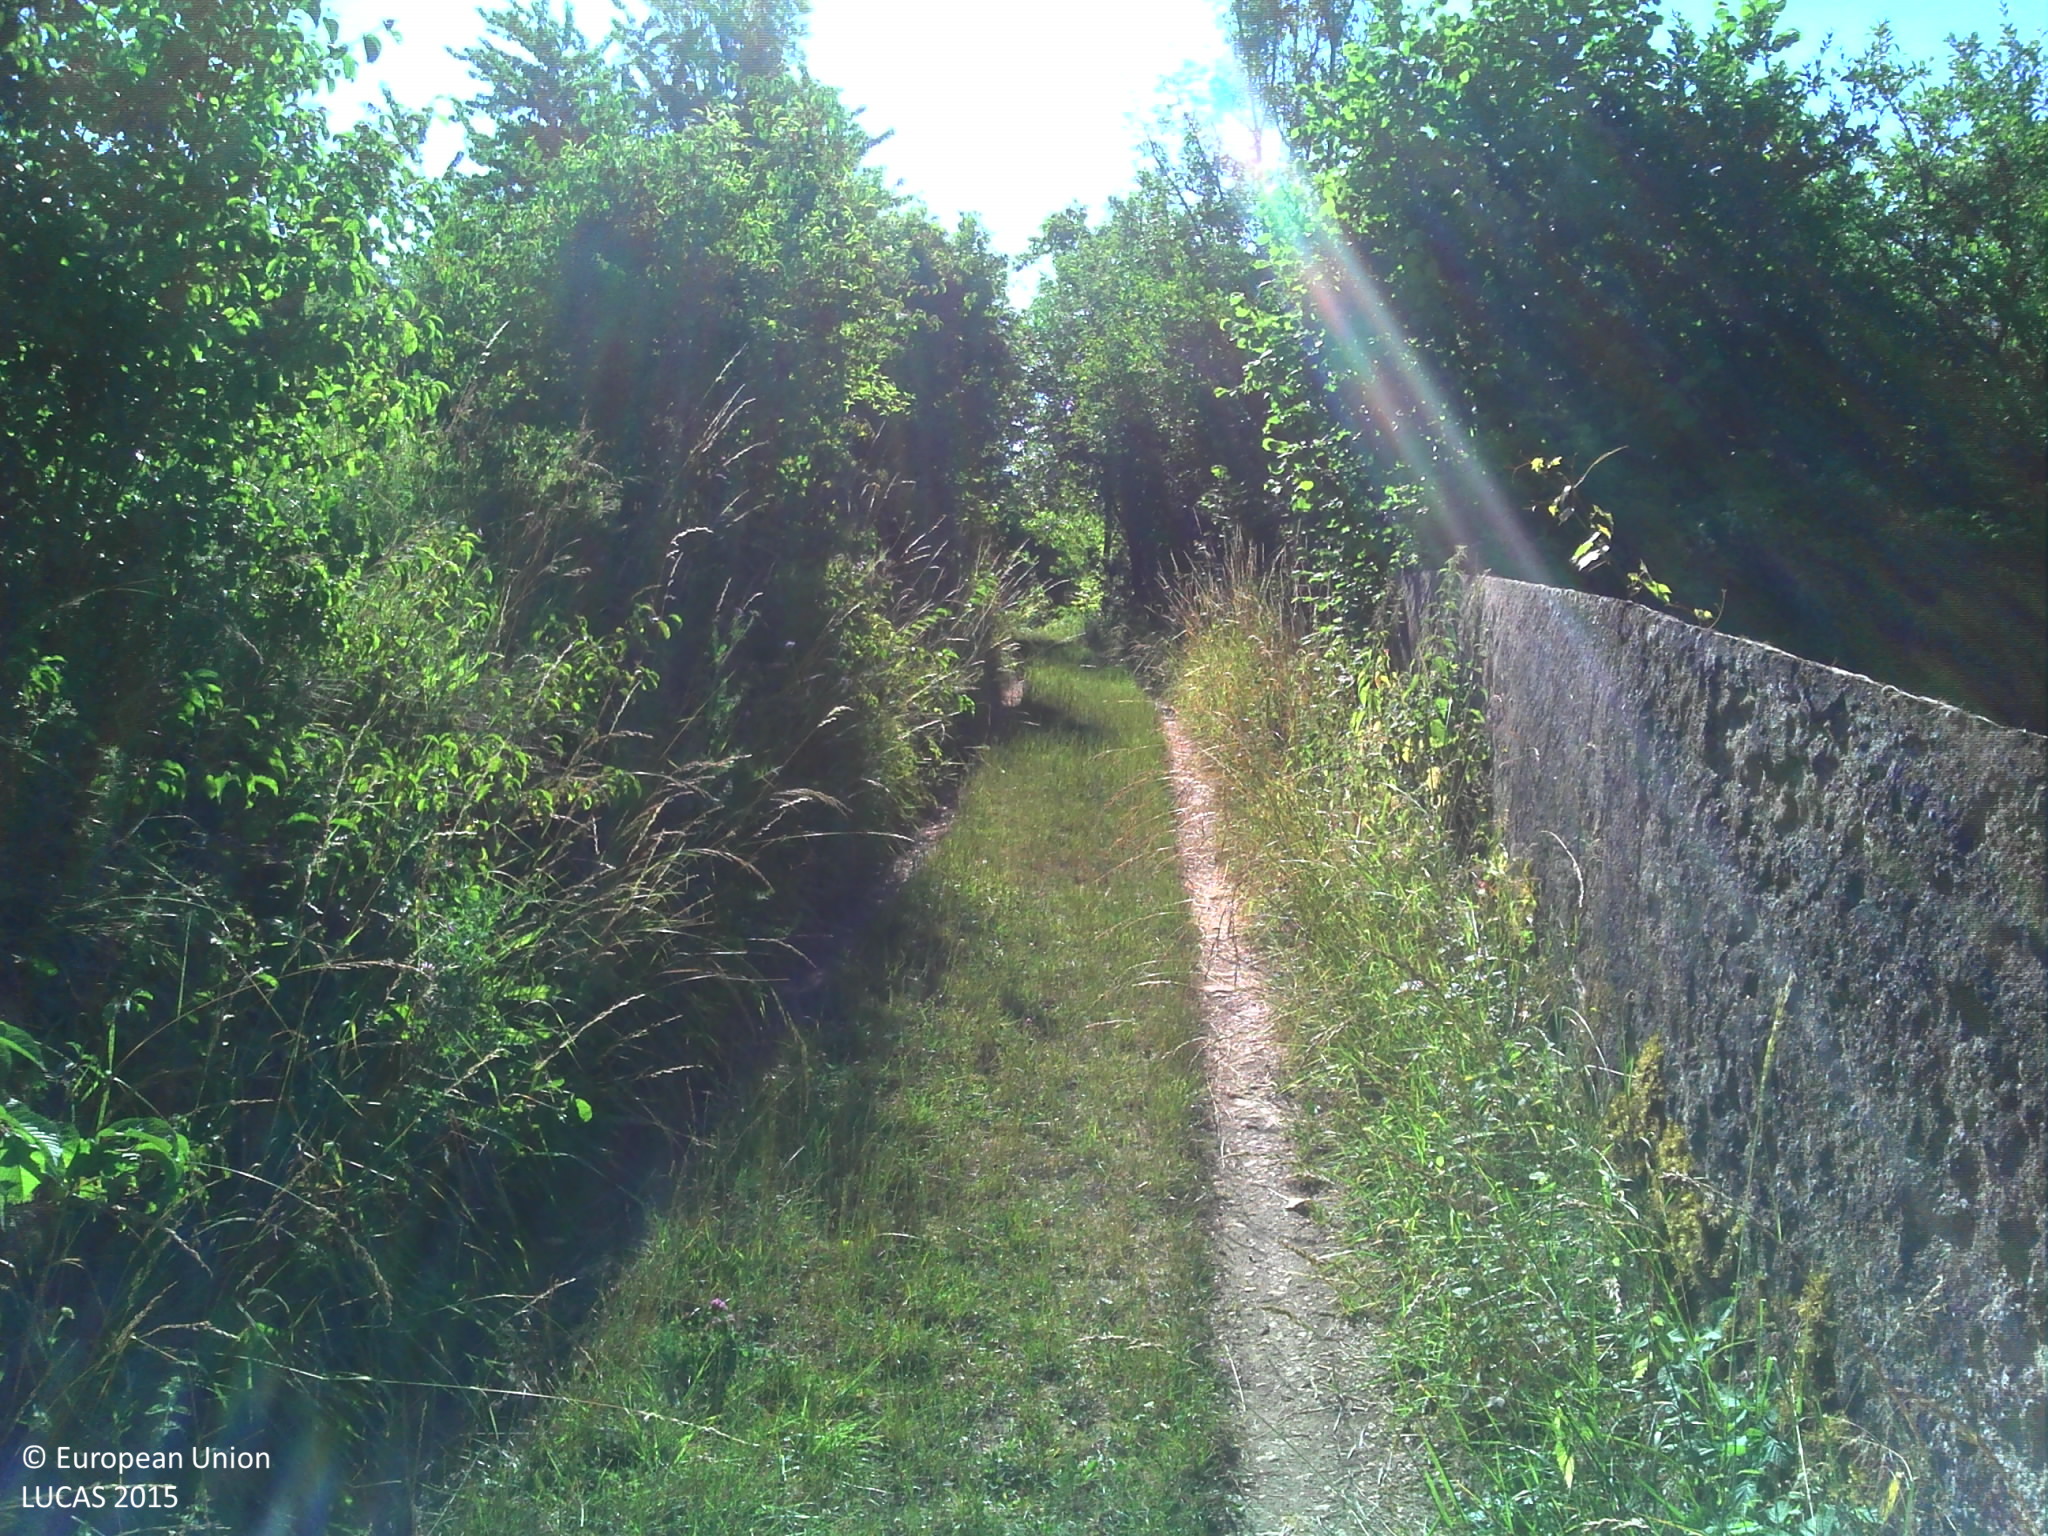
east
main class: Grassland
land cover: Grassland with sparse tree/shrub cover
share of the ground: > 75 %
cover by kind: herbaceous plants 95 %, broadleaved forest trees 5 %
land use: Residential
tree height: > 5 m
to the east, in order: Grassland with sparse tree/shrub cover; Dry stone walls; Broadleaved woodland; Fences; Grassland with sparse tree/shrub cover; Fences; Grassland without tree/shrub cover; Fences; Broadleaved woodland; Fences; Broadleaved woodland; Fences; Grassland without tree/shrub cover; Fences; Grassland without tree/shrub cover; Broadleaved woodland
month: June
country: FR
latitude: 49.0154
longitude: 5.9933
